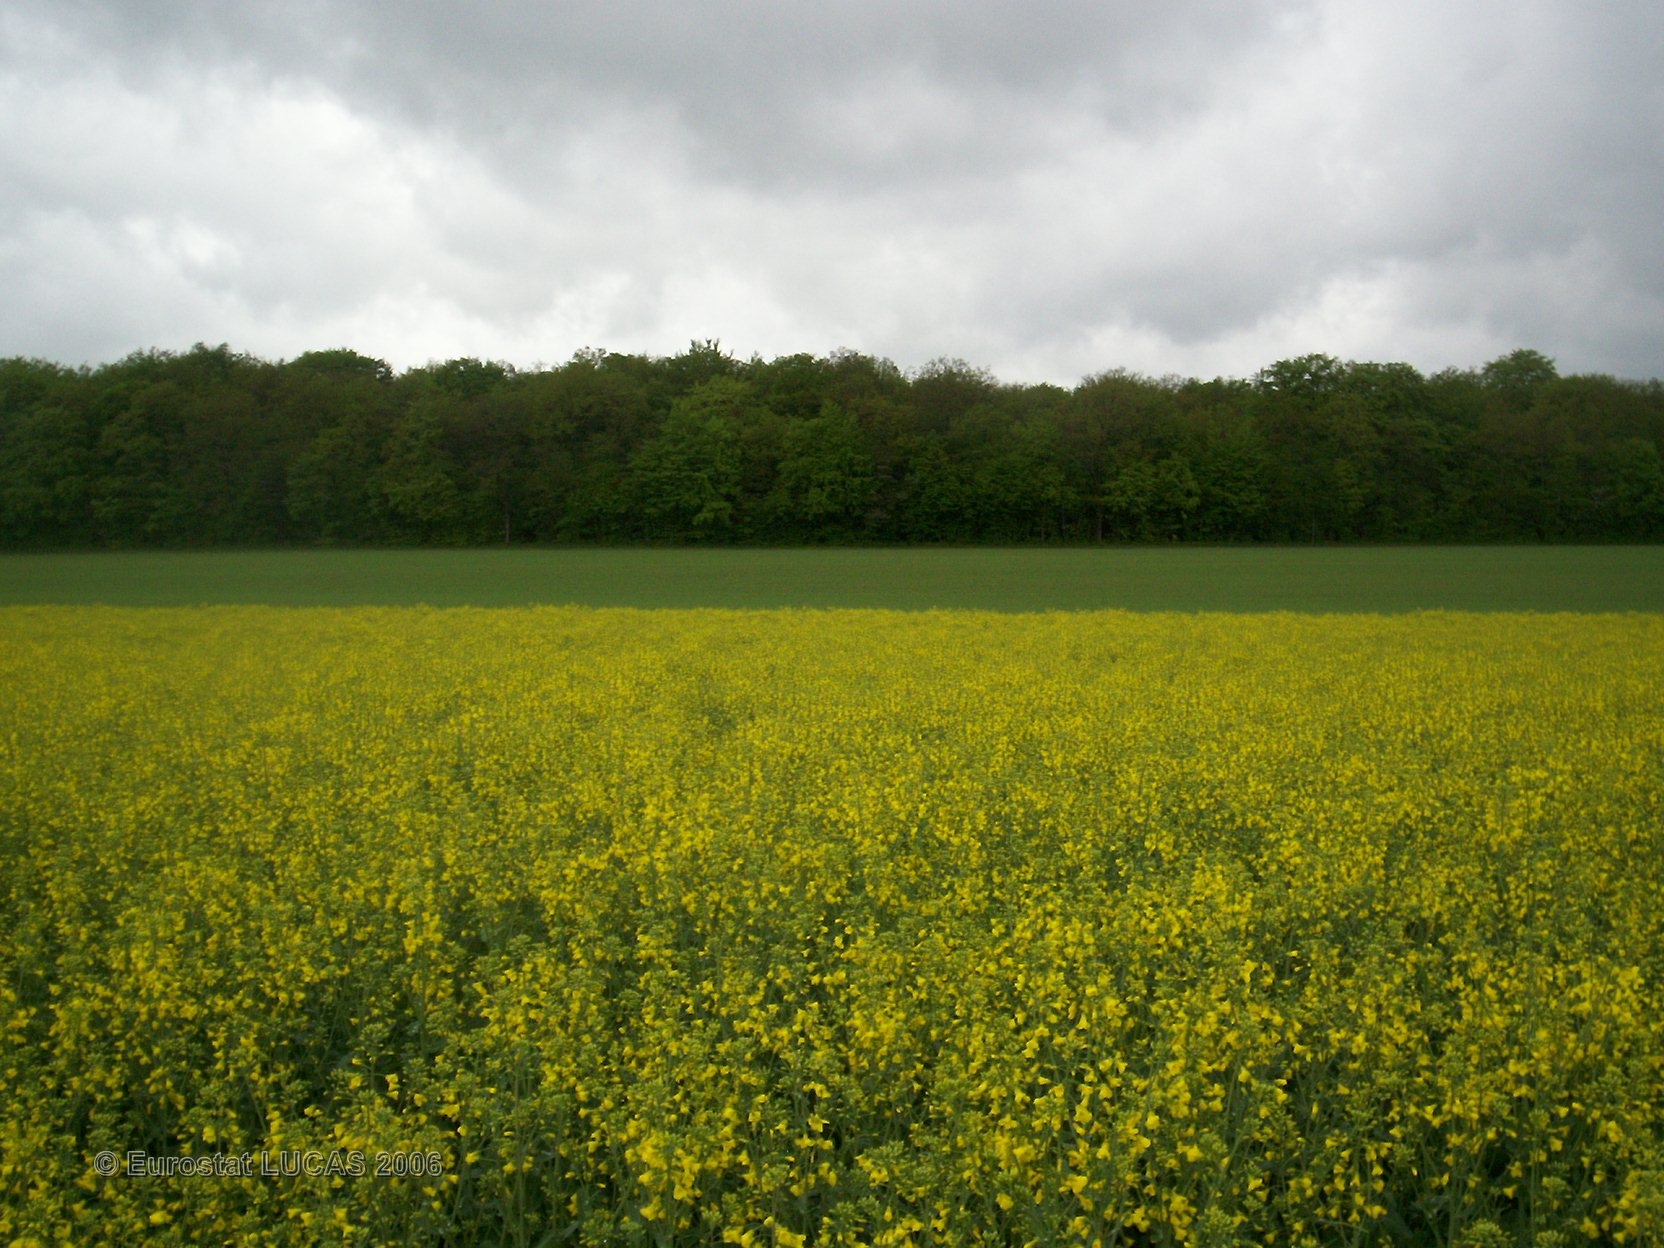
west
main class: Cropland
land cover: Rape and turnip rape
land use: Agriculture (excluding fallow land and kitchen gardens)
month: May
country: FR
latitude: 47.7843
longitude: 4.5931
